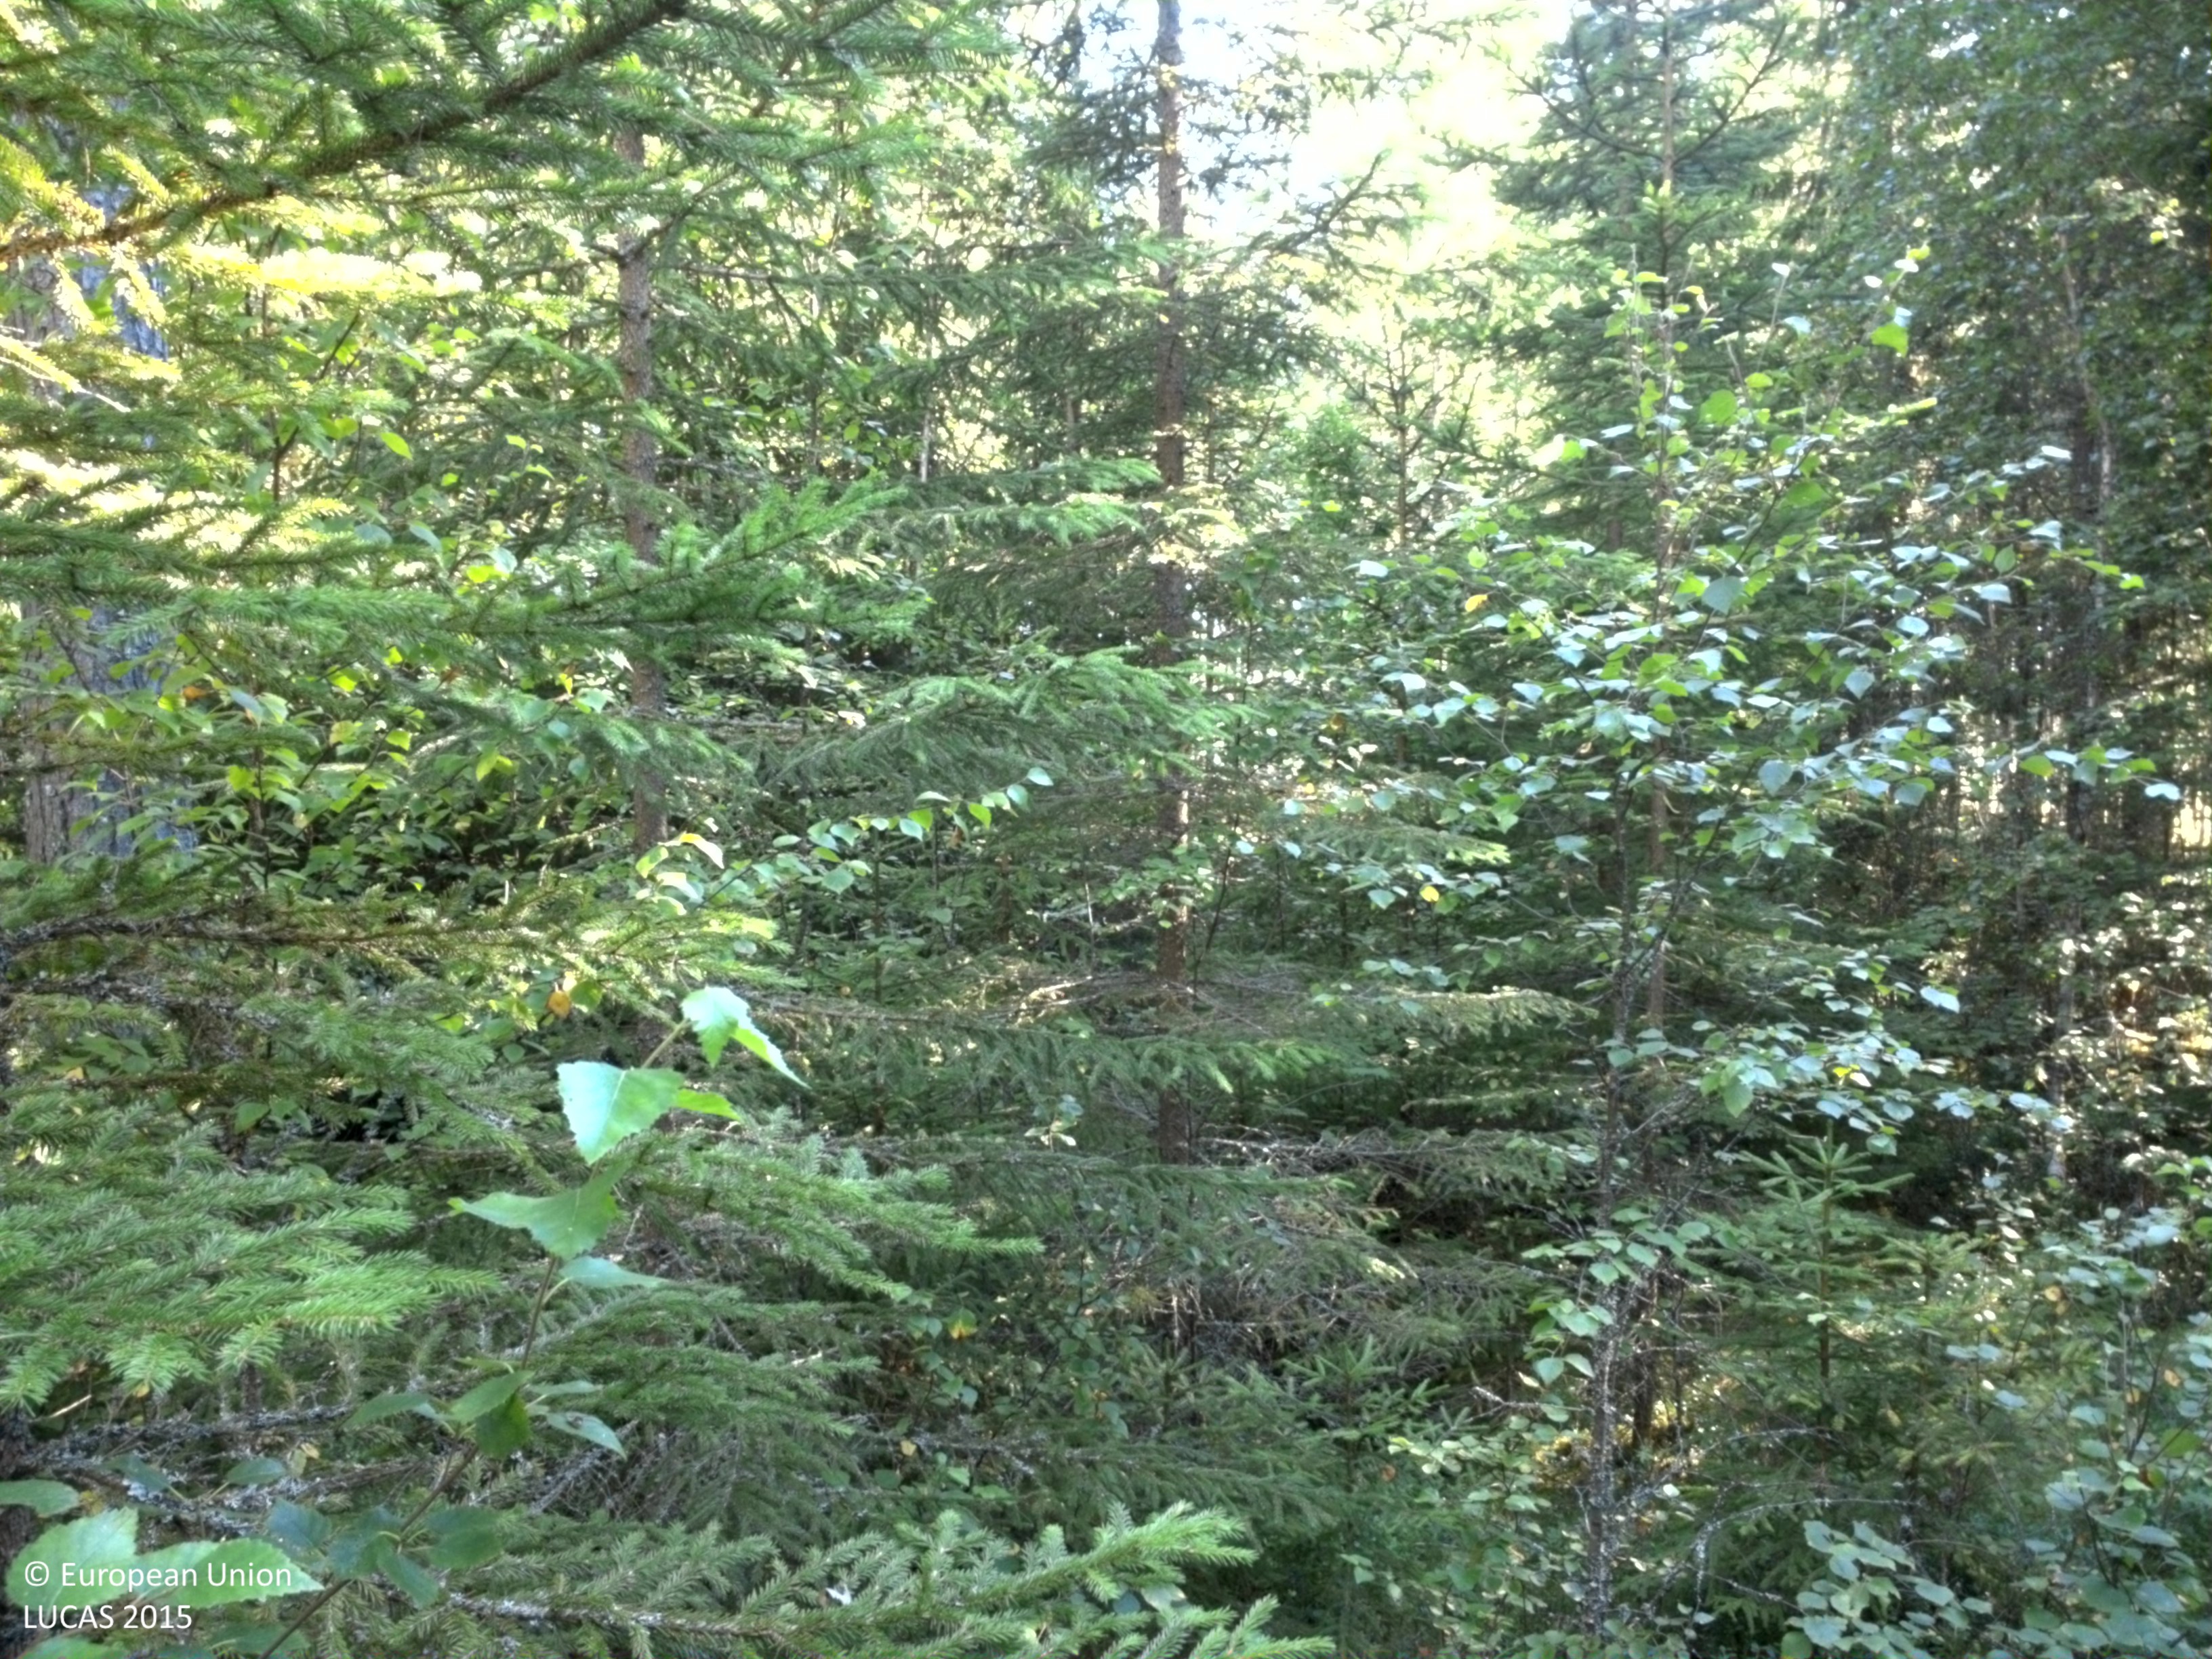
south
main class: Woodland
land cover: Spruce dominated mixed woodland
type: boreal forest
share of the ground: > 75 %
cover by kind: coniferous forest trees 50 %, broadleaved forest trees 35 %, shrubs 15 %
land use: Forestry
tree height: > 5 m
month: August
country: SE
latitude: 59.7774
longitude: 14.1404
